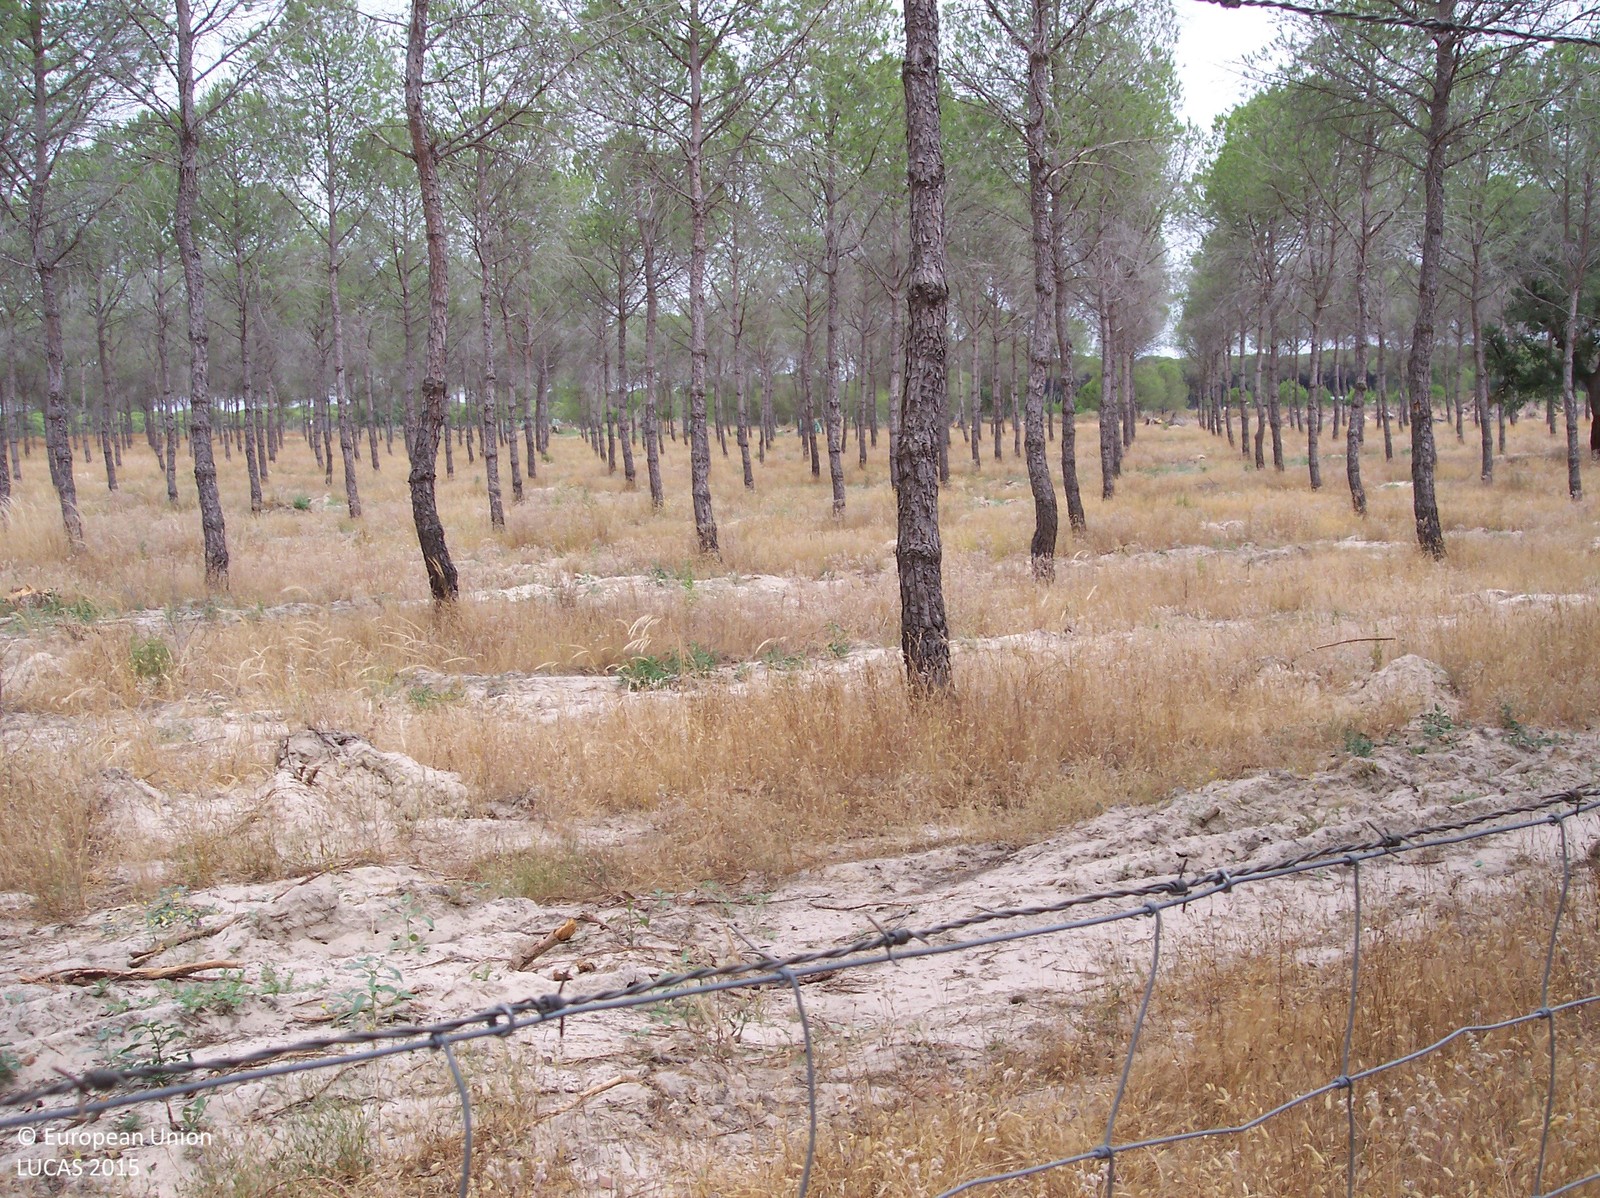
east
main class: Woodland
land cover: Pine dominated coniferous woodland
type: coniferous forest of the mediterranean region
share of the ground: 50 - 75 %
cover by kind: coniferous forest trees 60 %, herbaceous plants 20 %, shrubs 10 %, unconsolidated bare surface 10 %
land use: Forestry
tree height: > 5 m
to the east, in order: Pine dominated coniferous woodland
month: June
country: ES
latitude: 37.2919
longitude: -6.3964
